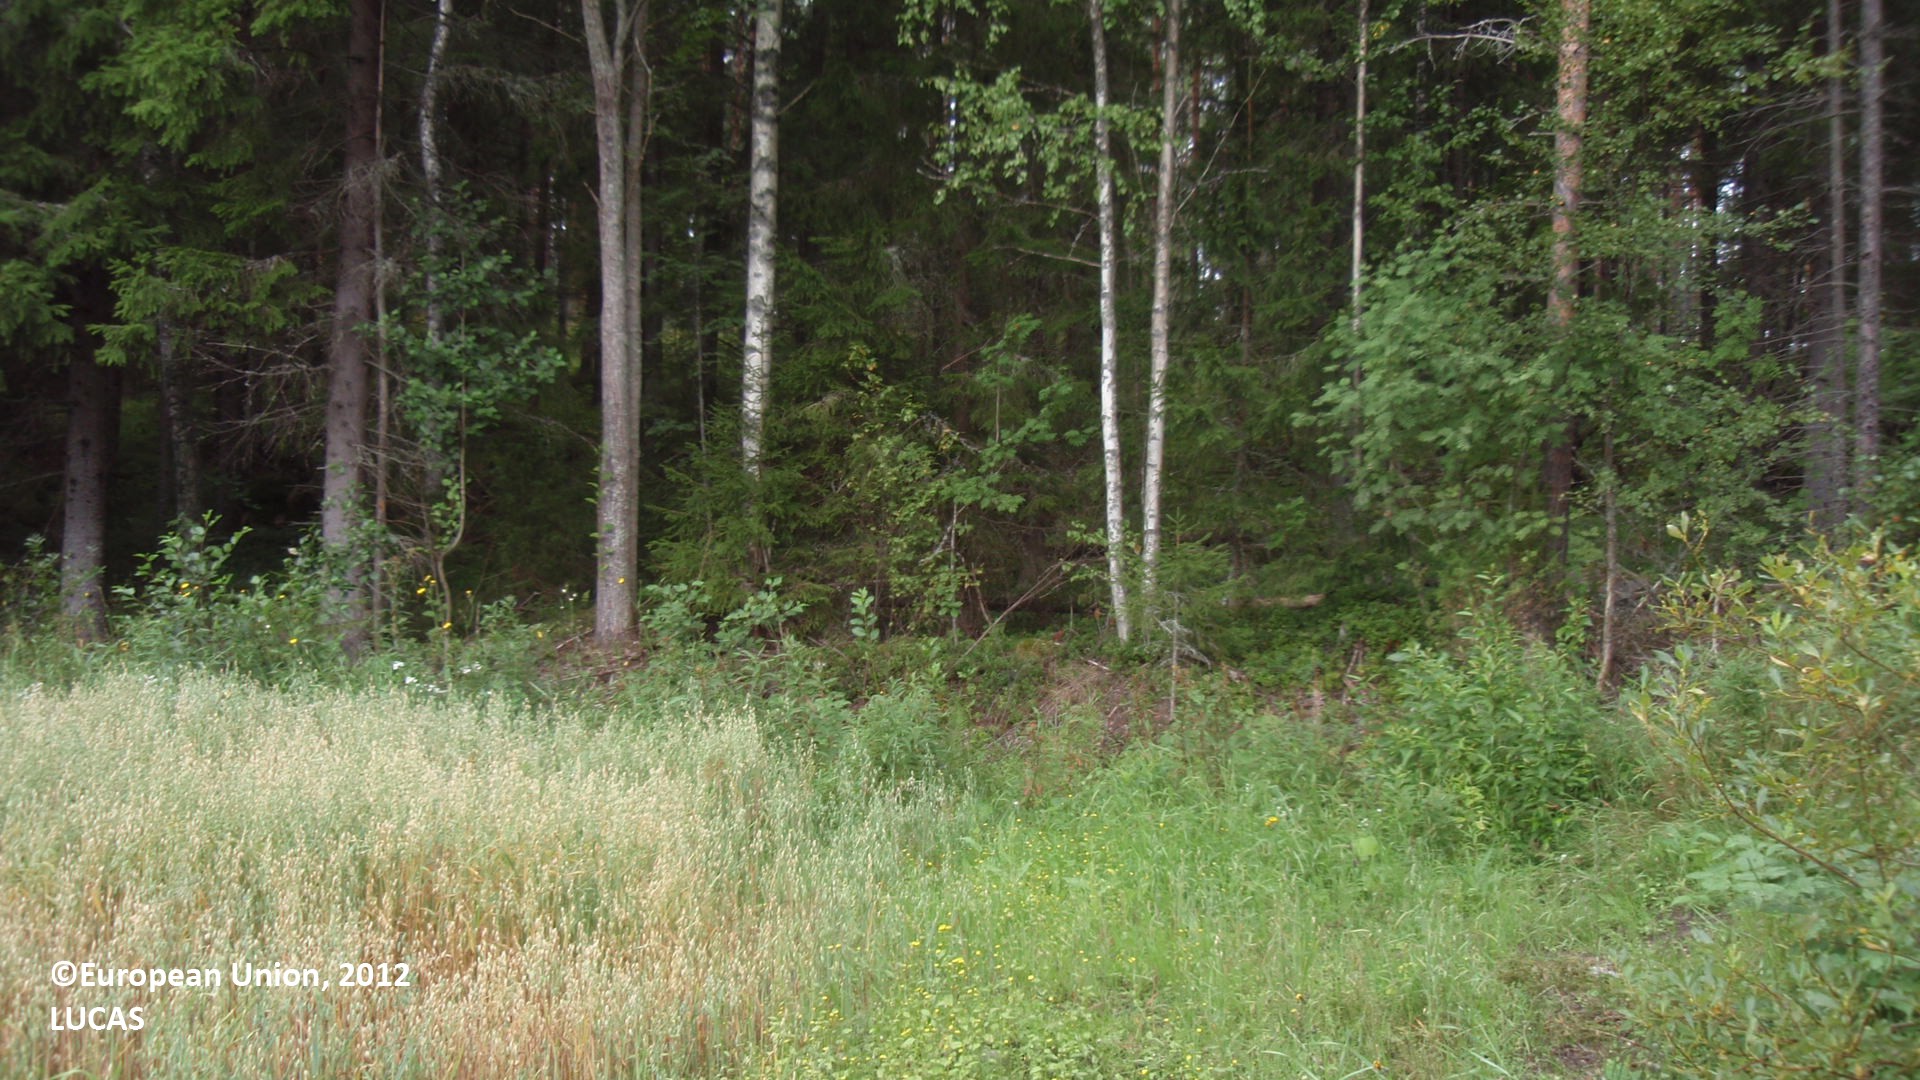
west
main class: Cropland
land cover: Oats
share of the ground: > 75 %
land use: Agriculture (excluding fallow land and kitchen gardens)
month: August
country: FI
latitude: 60.9938
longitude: 27.5432
